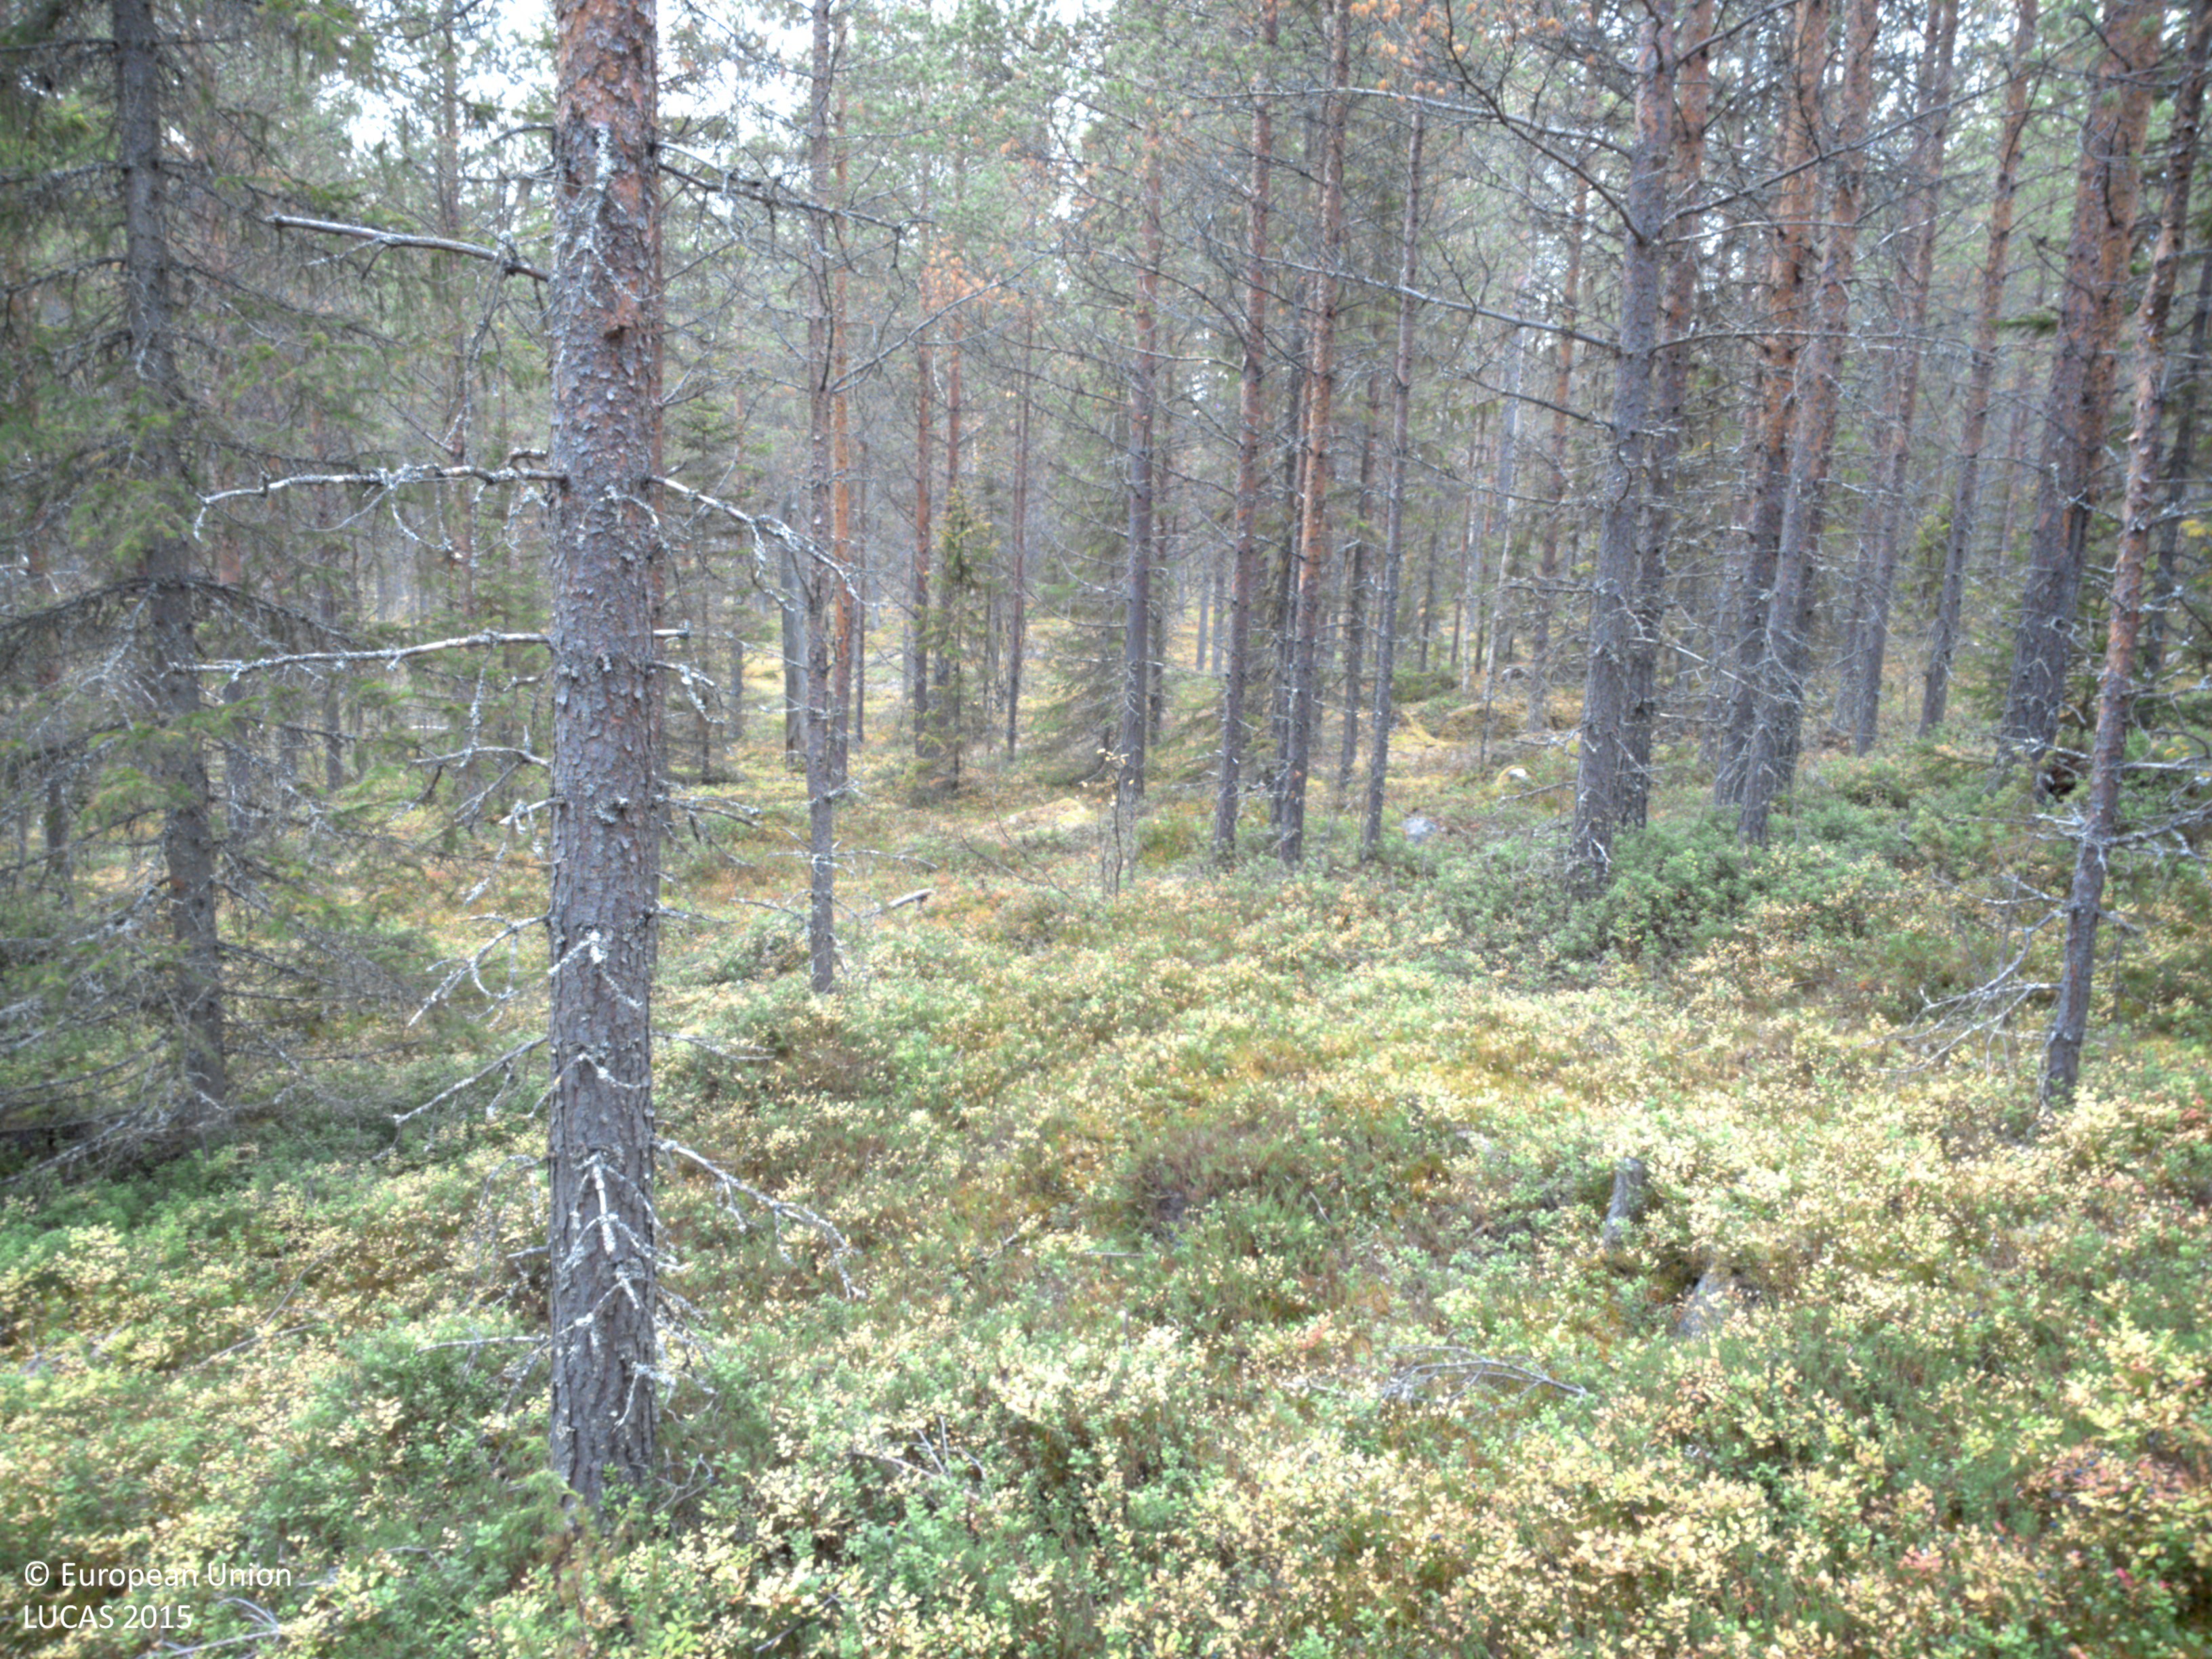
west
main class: Woodland
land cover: Other coniferous woodland
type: boreal forest
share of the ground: > 75 %
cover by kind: coniferous forest trees 80 %, shrubs 10 %, lichens and mosses 10 %
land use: Forestry
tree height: > 5 m
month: October
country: SE
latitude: 64.9536
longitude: 18.1146
